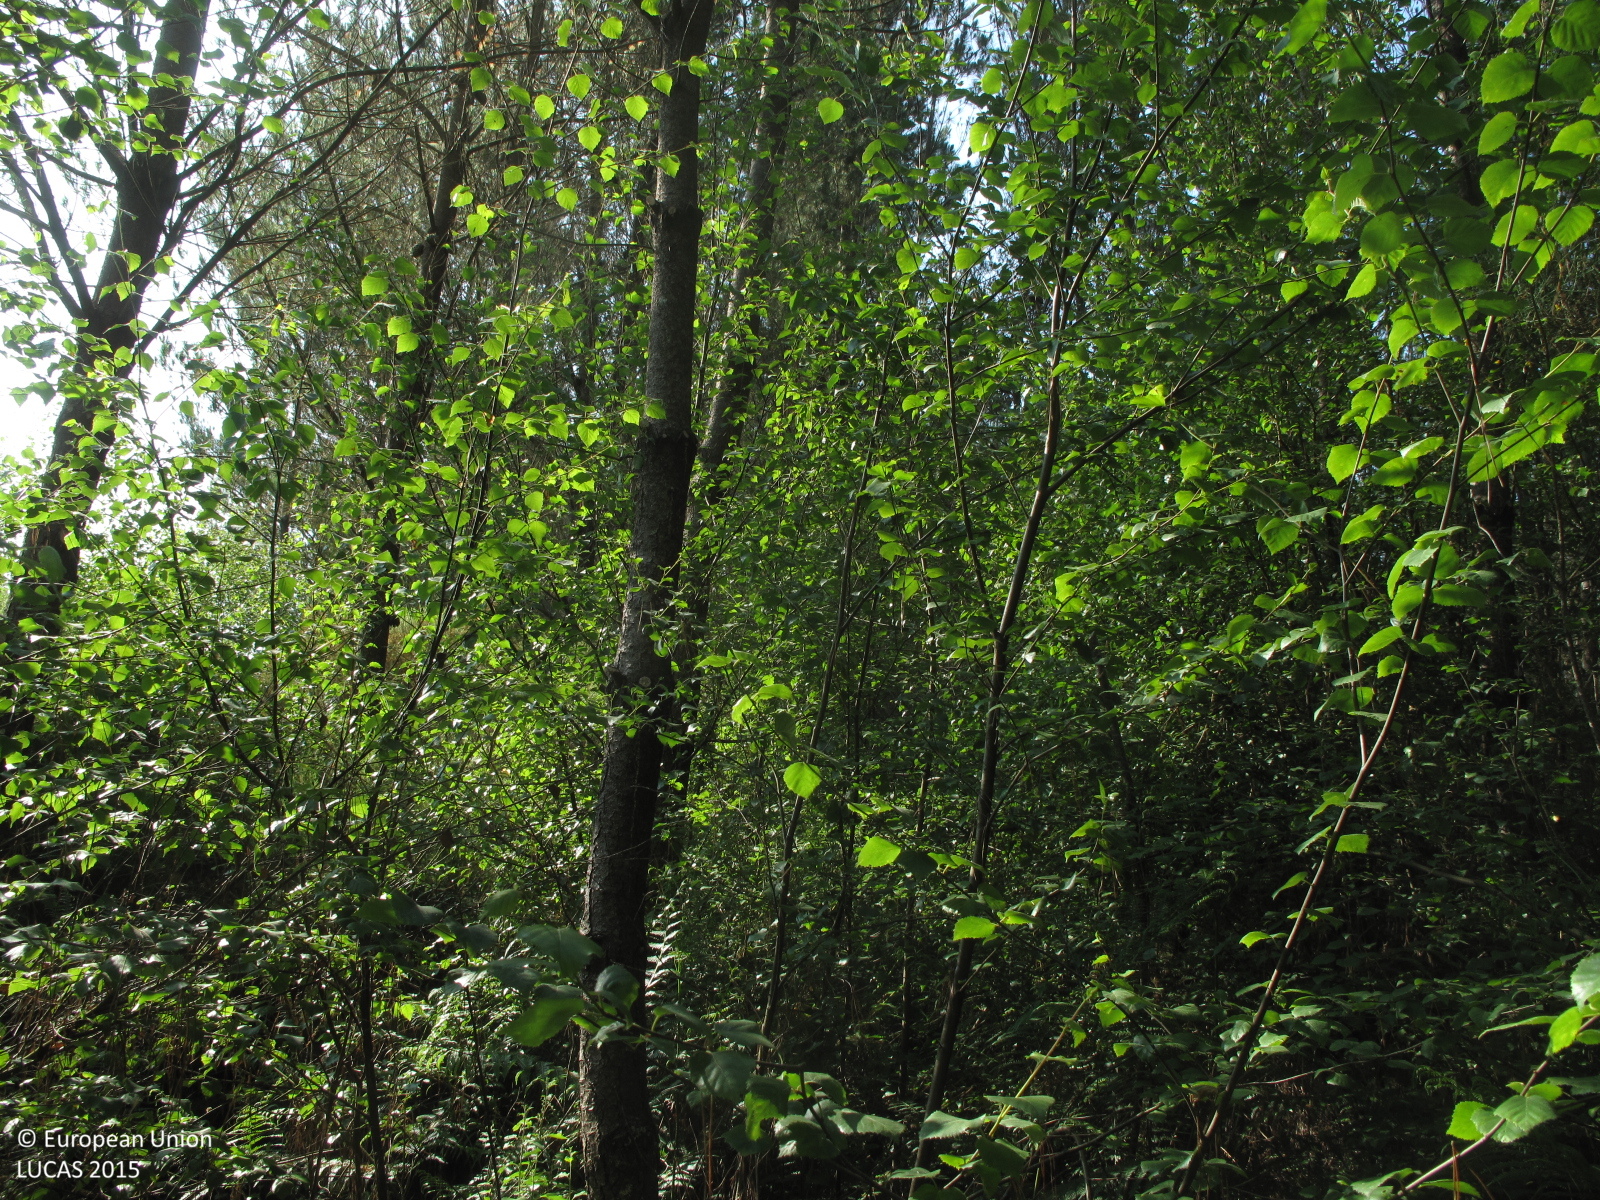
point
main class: Woodland
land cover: Pine dominated coniferous woodland
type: exotic forest
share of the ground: 50 - 75 %
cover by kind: coniferous forest trees 60 %, shrubs 20 %, broadleaved forest trees 10 %, herbaceous plants 10 %
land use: Forestry
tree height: > 5 m
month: June
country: ES
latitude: 43.0197
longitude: -7.8916
